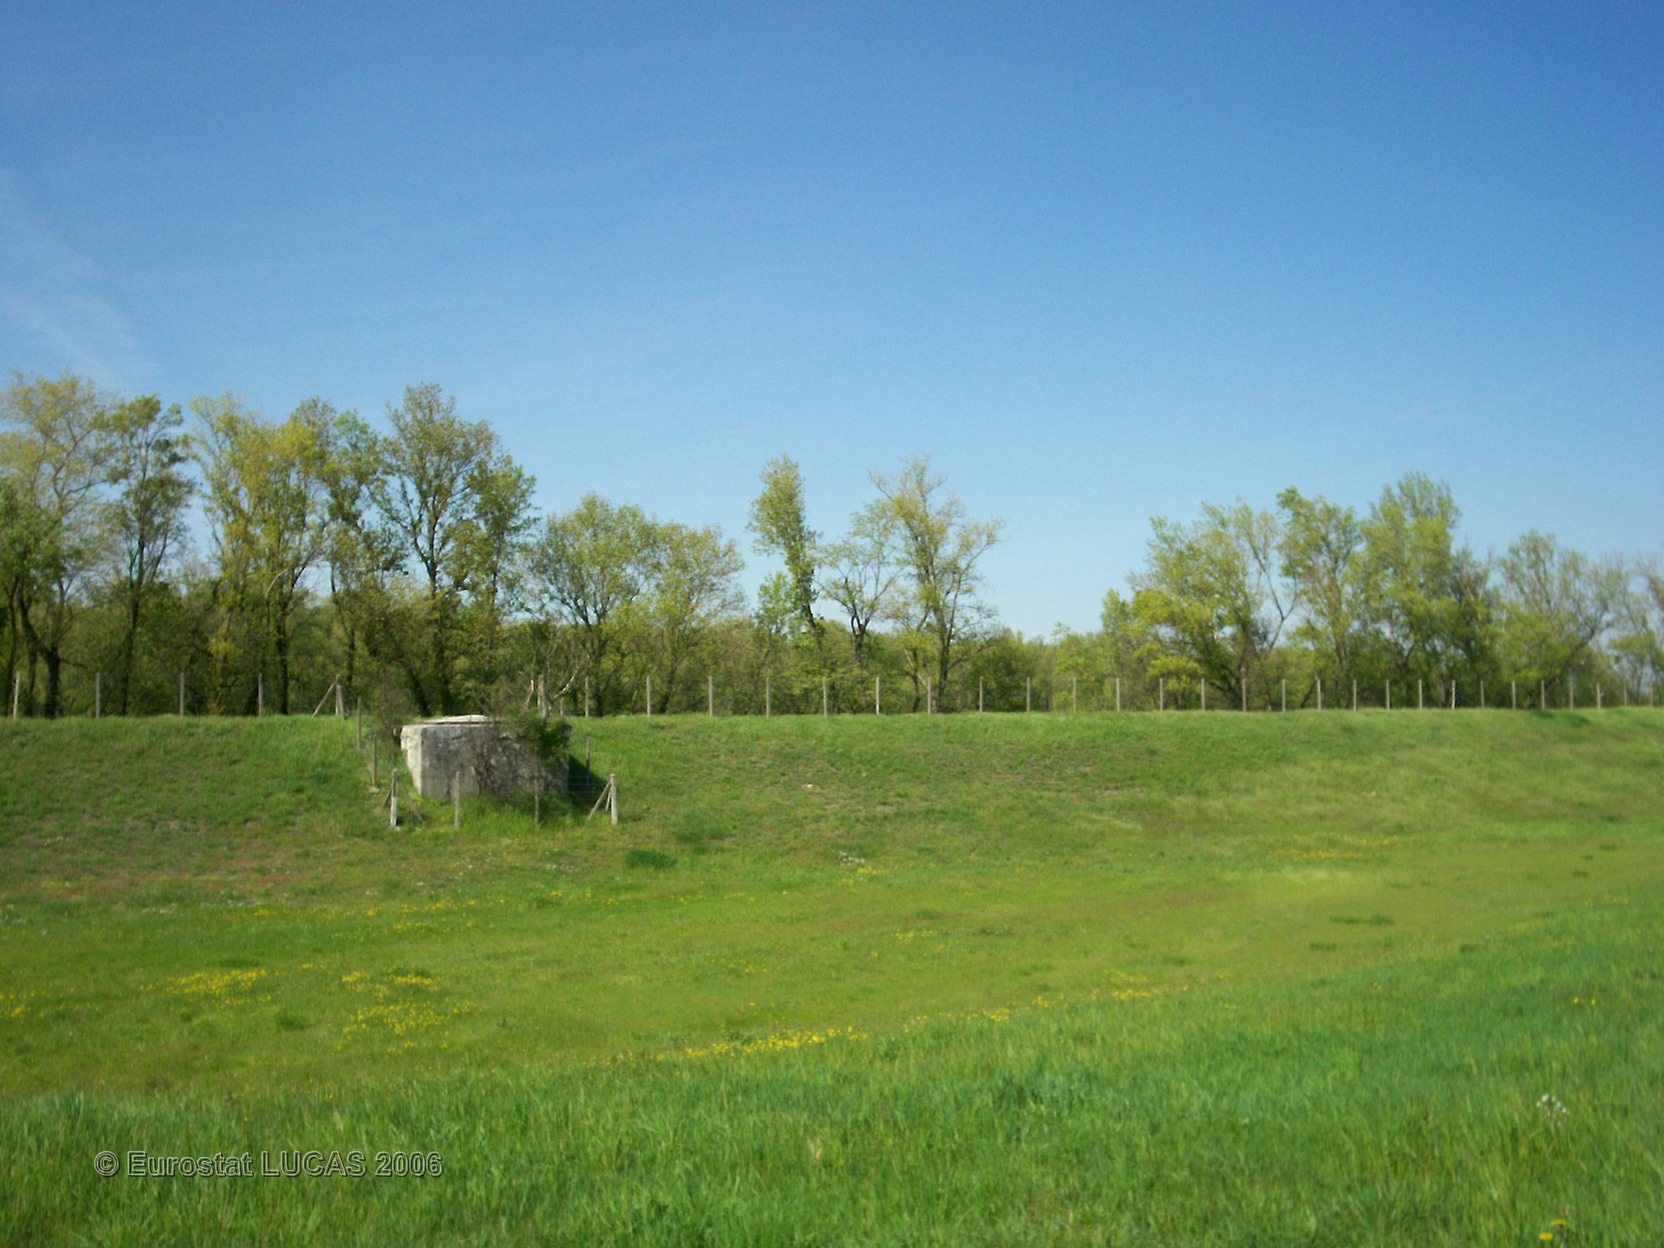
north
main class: Grassland
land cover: Grassland without tree/shrub cover
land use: Road transport
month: April
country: FR
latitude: 45.5923
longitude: 4.7867
